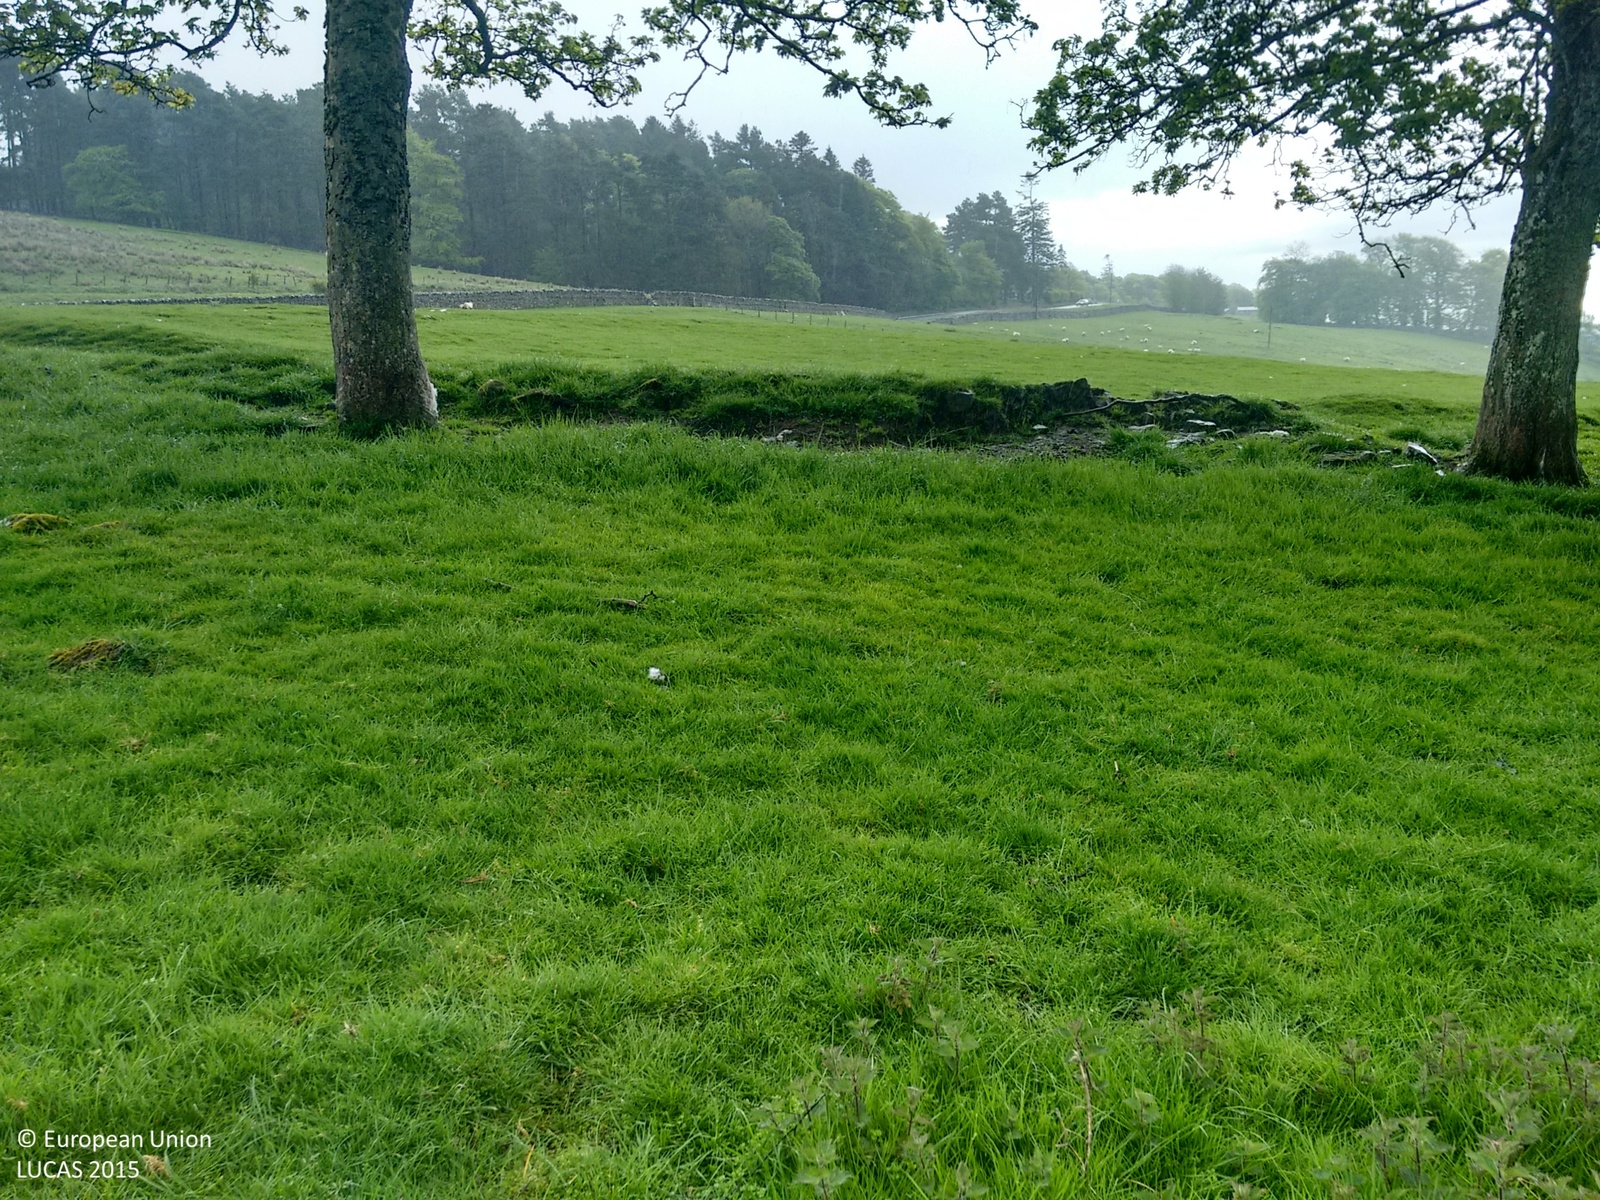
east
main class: Grassland
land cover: Grassland without tree/shrub cover
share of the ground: > 75 %
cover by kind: herbaceous plants 100 %
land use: Agriculture (excluding fallow land and kitchen gardens)
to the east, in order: Grassland without tree/shrub cover; Managed hedges; Tracks; Grassland without tree/shrub cover; Dry stone walls; Grass margins; Paved roads, cycling and walking lanes; Grass margins; Fences; Grassland without tree/shrub cover; Tracks; Grassland without tree/shrub cover; Dry stone walls; Pine dominated mixed woodland
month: May
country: GB
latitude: 55.2699
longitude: -2.2554
